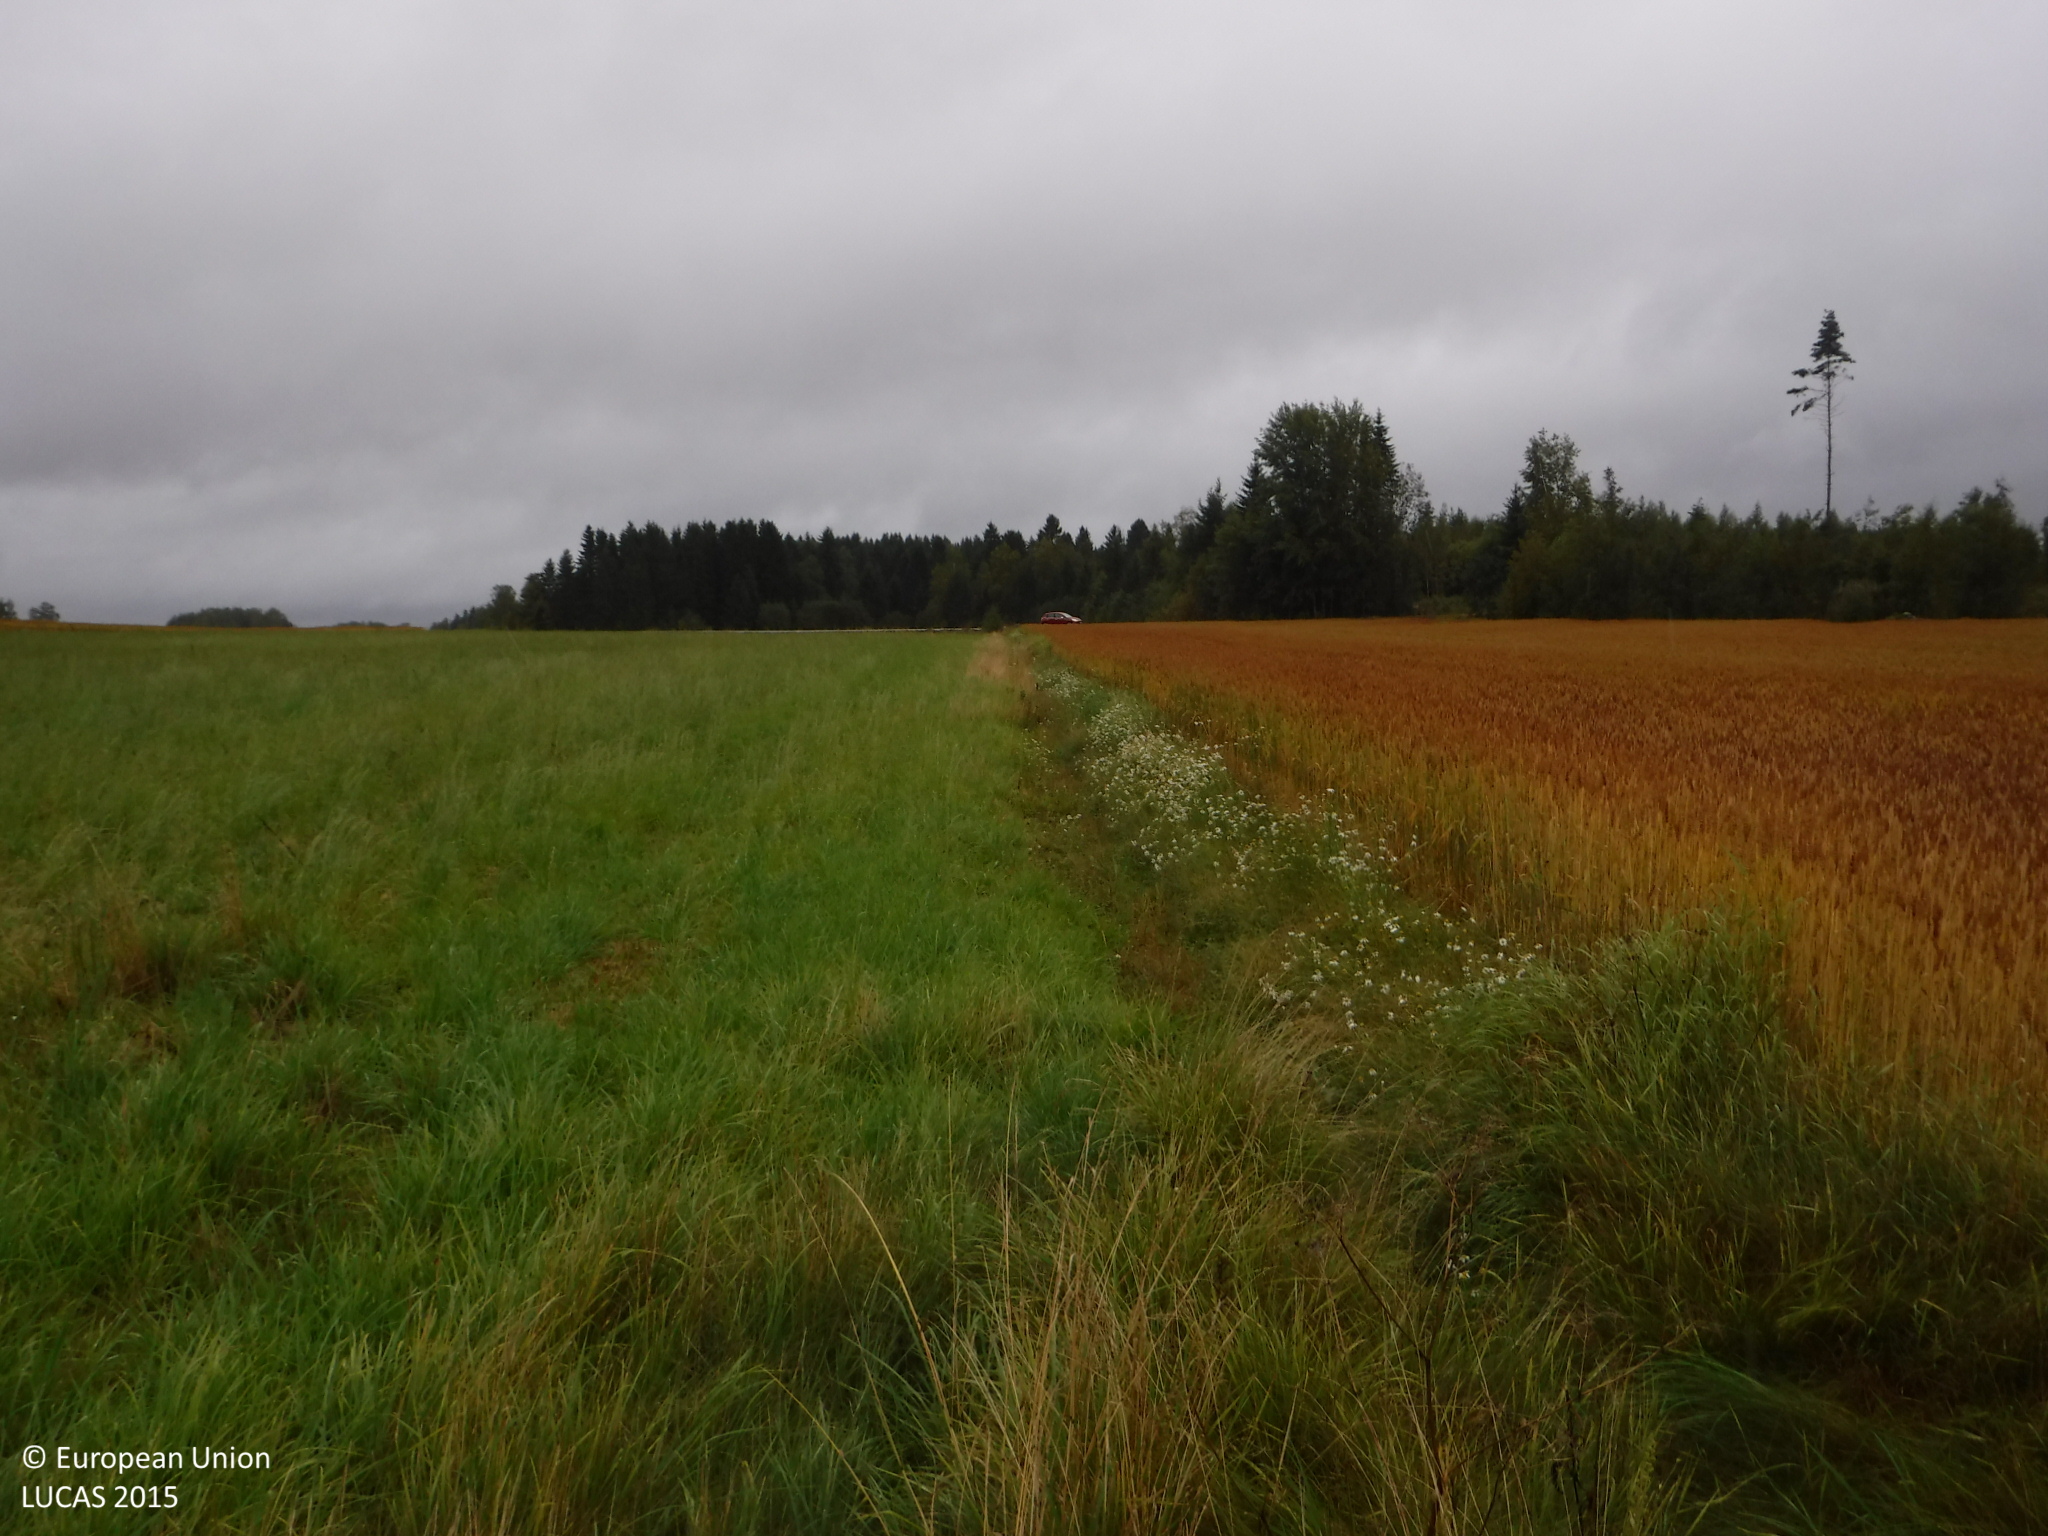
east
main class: Cropland
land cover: Temporary grasslands
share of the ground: > 75 %
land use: Agriculture (excluding fallow land and kitchen gardens)
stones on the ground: < 10 %
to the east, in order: Temporary grasslands; Tracks; Grass margins; Common wheat; Ditches and canals; Grass margins; Paved roads, cycling and walking lanes; Grass margins; Ditches and canals; Temporary grasslands
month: September
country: FI
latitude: 61.3331
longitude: 22.9845
